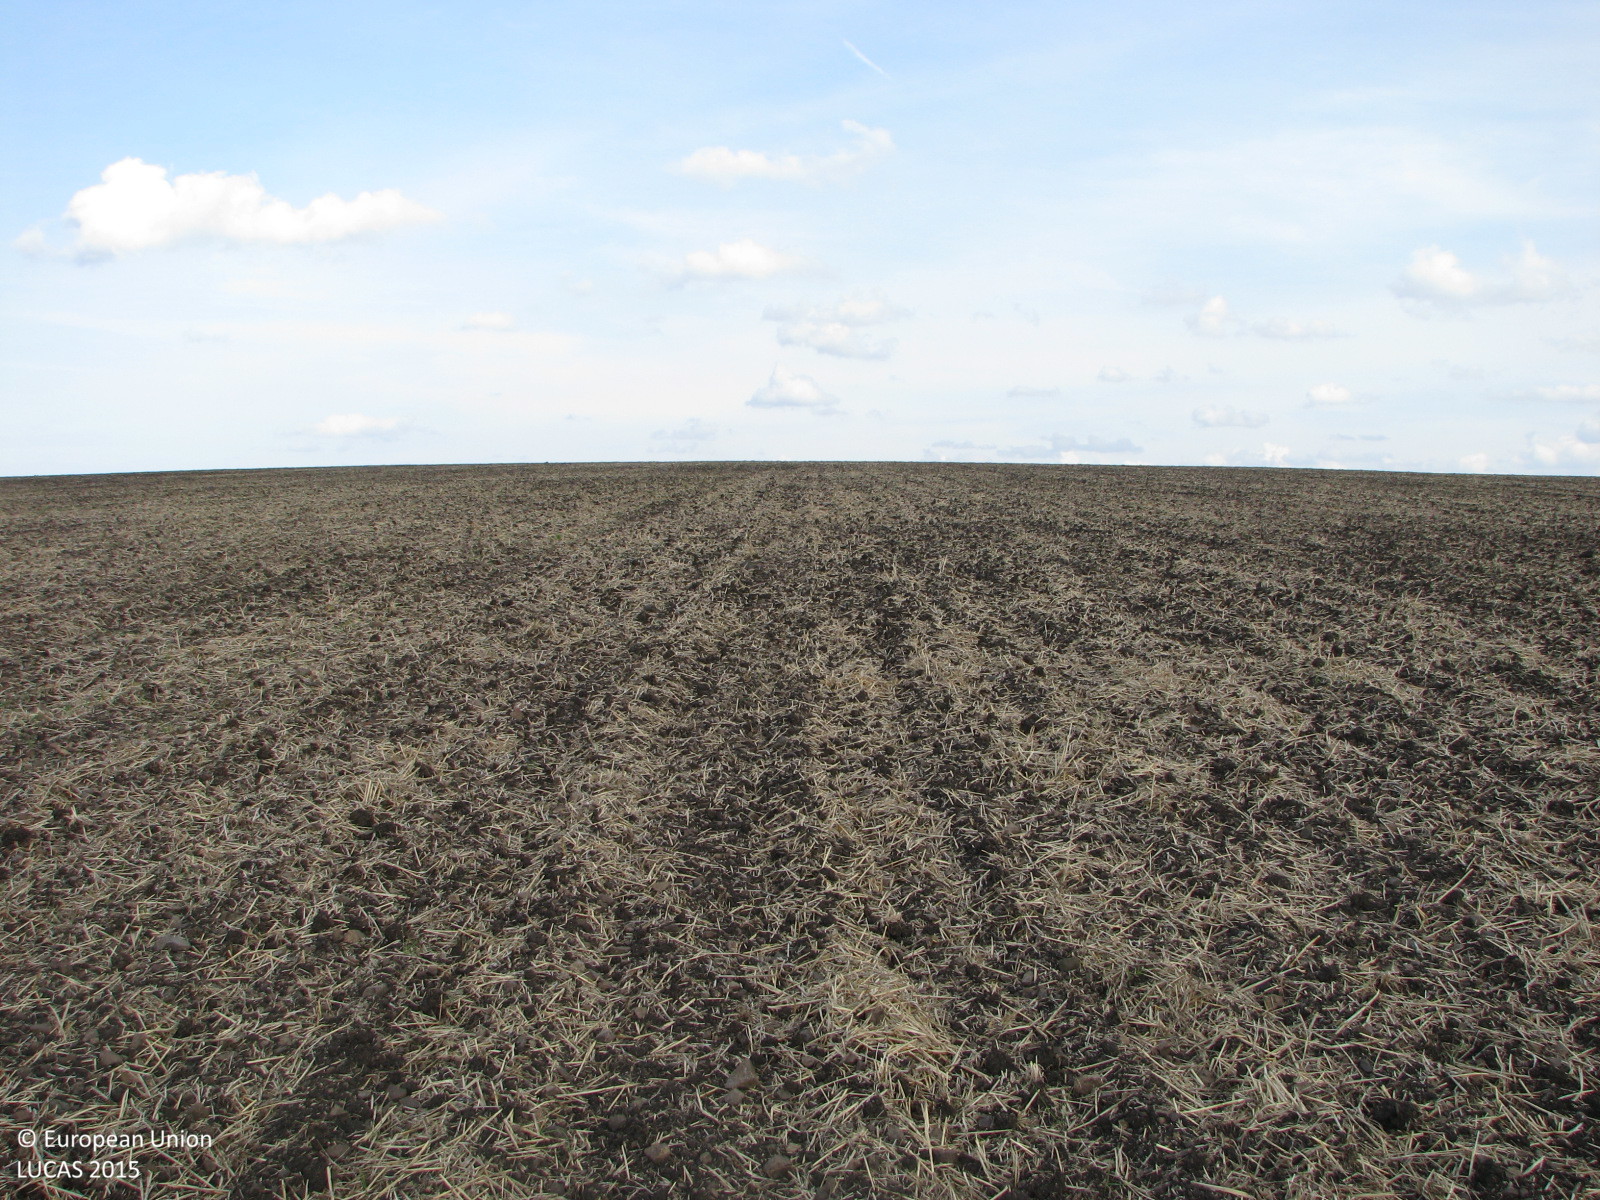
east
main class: Cropland
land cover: Common wheat
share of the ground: < 10 %
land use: Agriculture (excluding fallow land and kitchen gardens)
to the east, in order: Common wheat
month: September
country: BG
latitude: 42.4642
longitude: 26.8468
